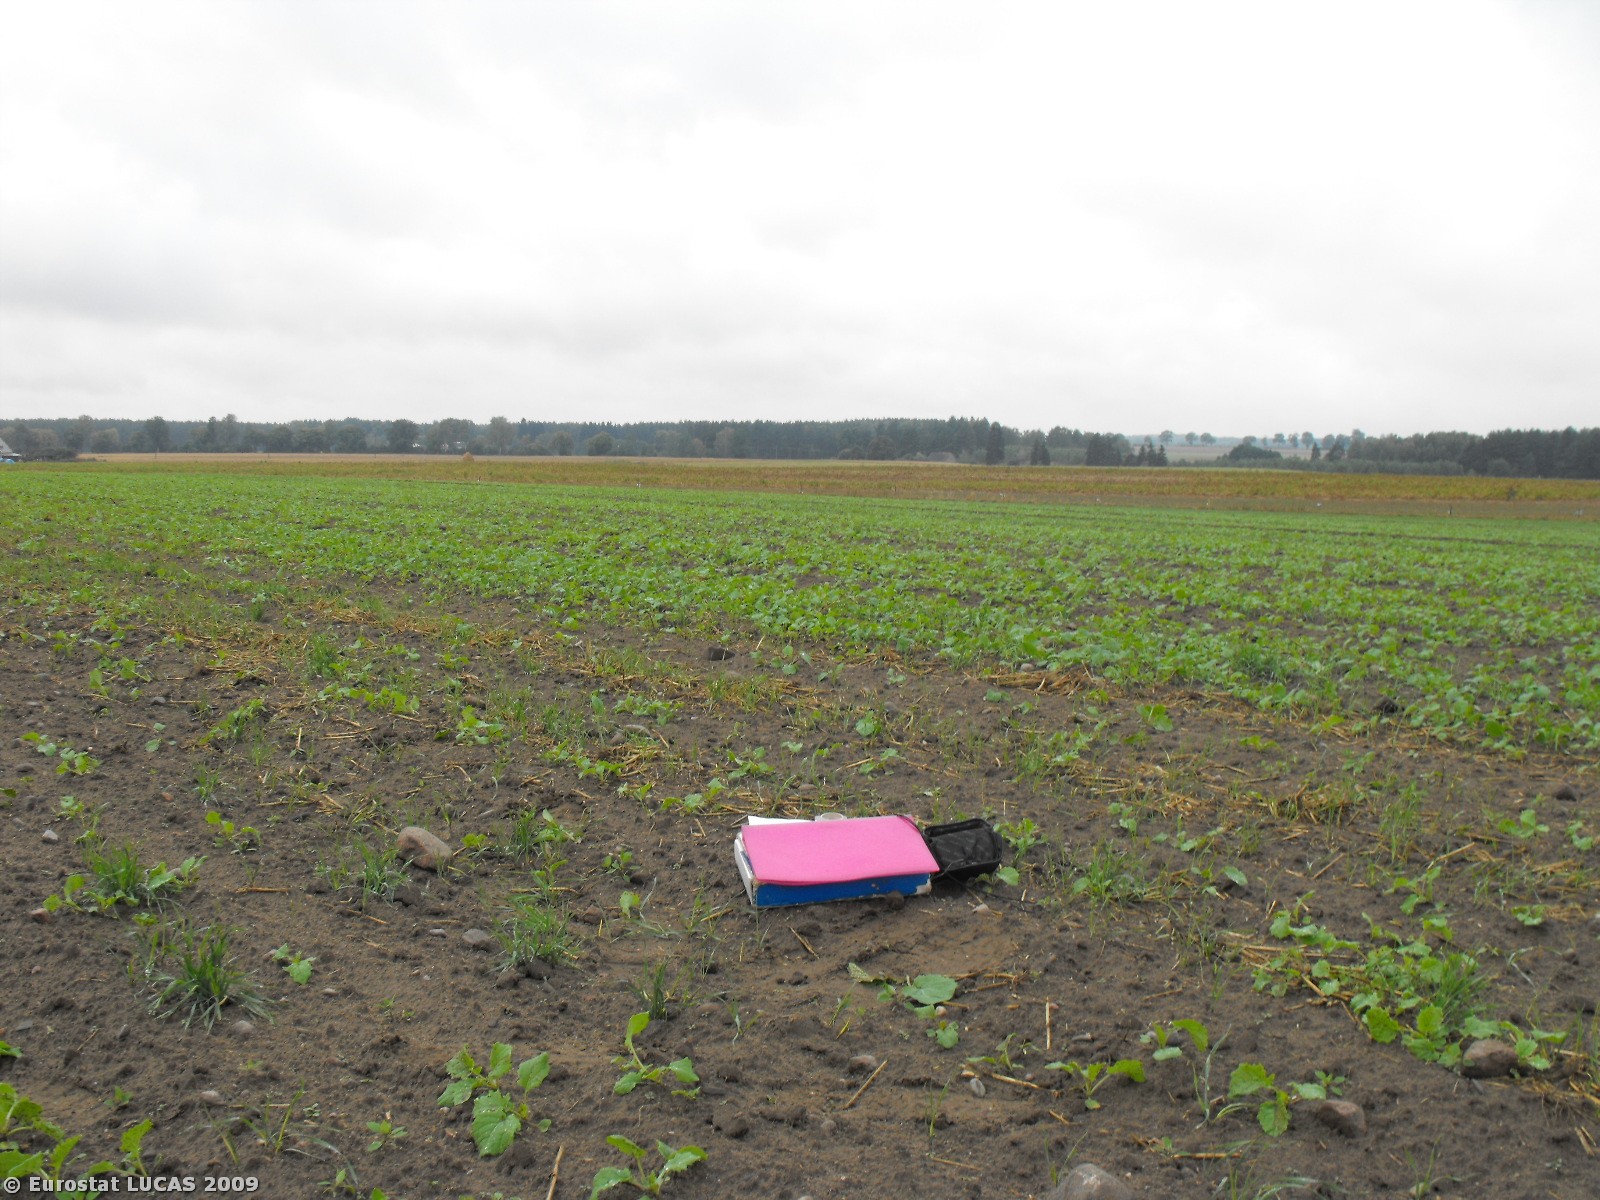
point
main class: Cropland
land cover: Triticale
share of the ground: < 10 %
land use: Agriculture (excluding fallow land and kitchen gardens)
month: September
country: PL
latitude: 53.4979
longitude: 17.1401
